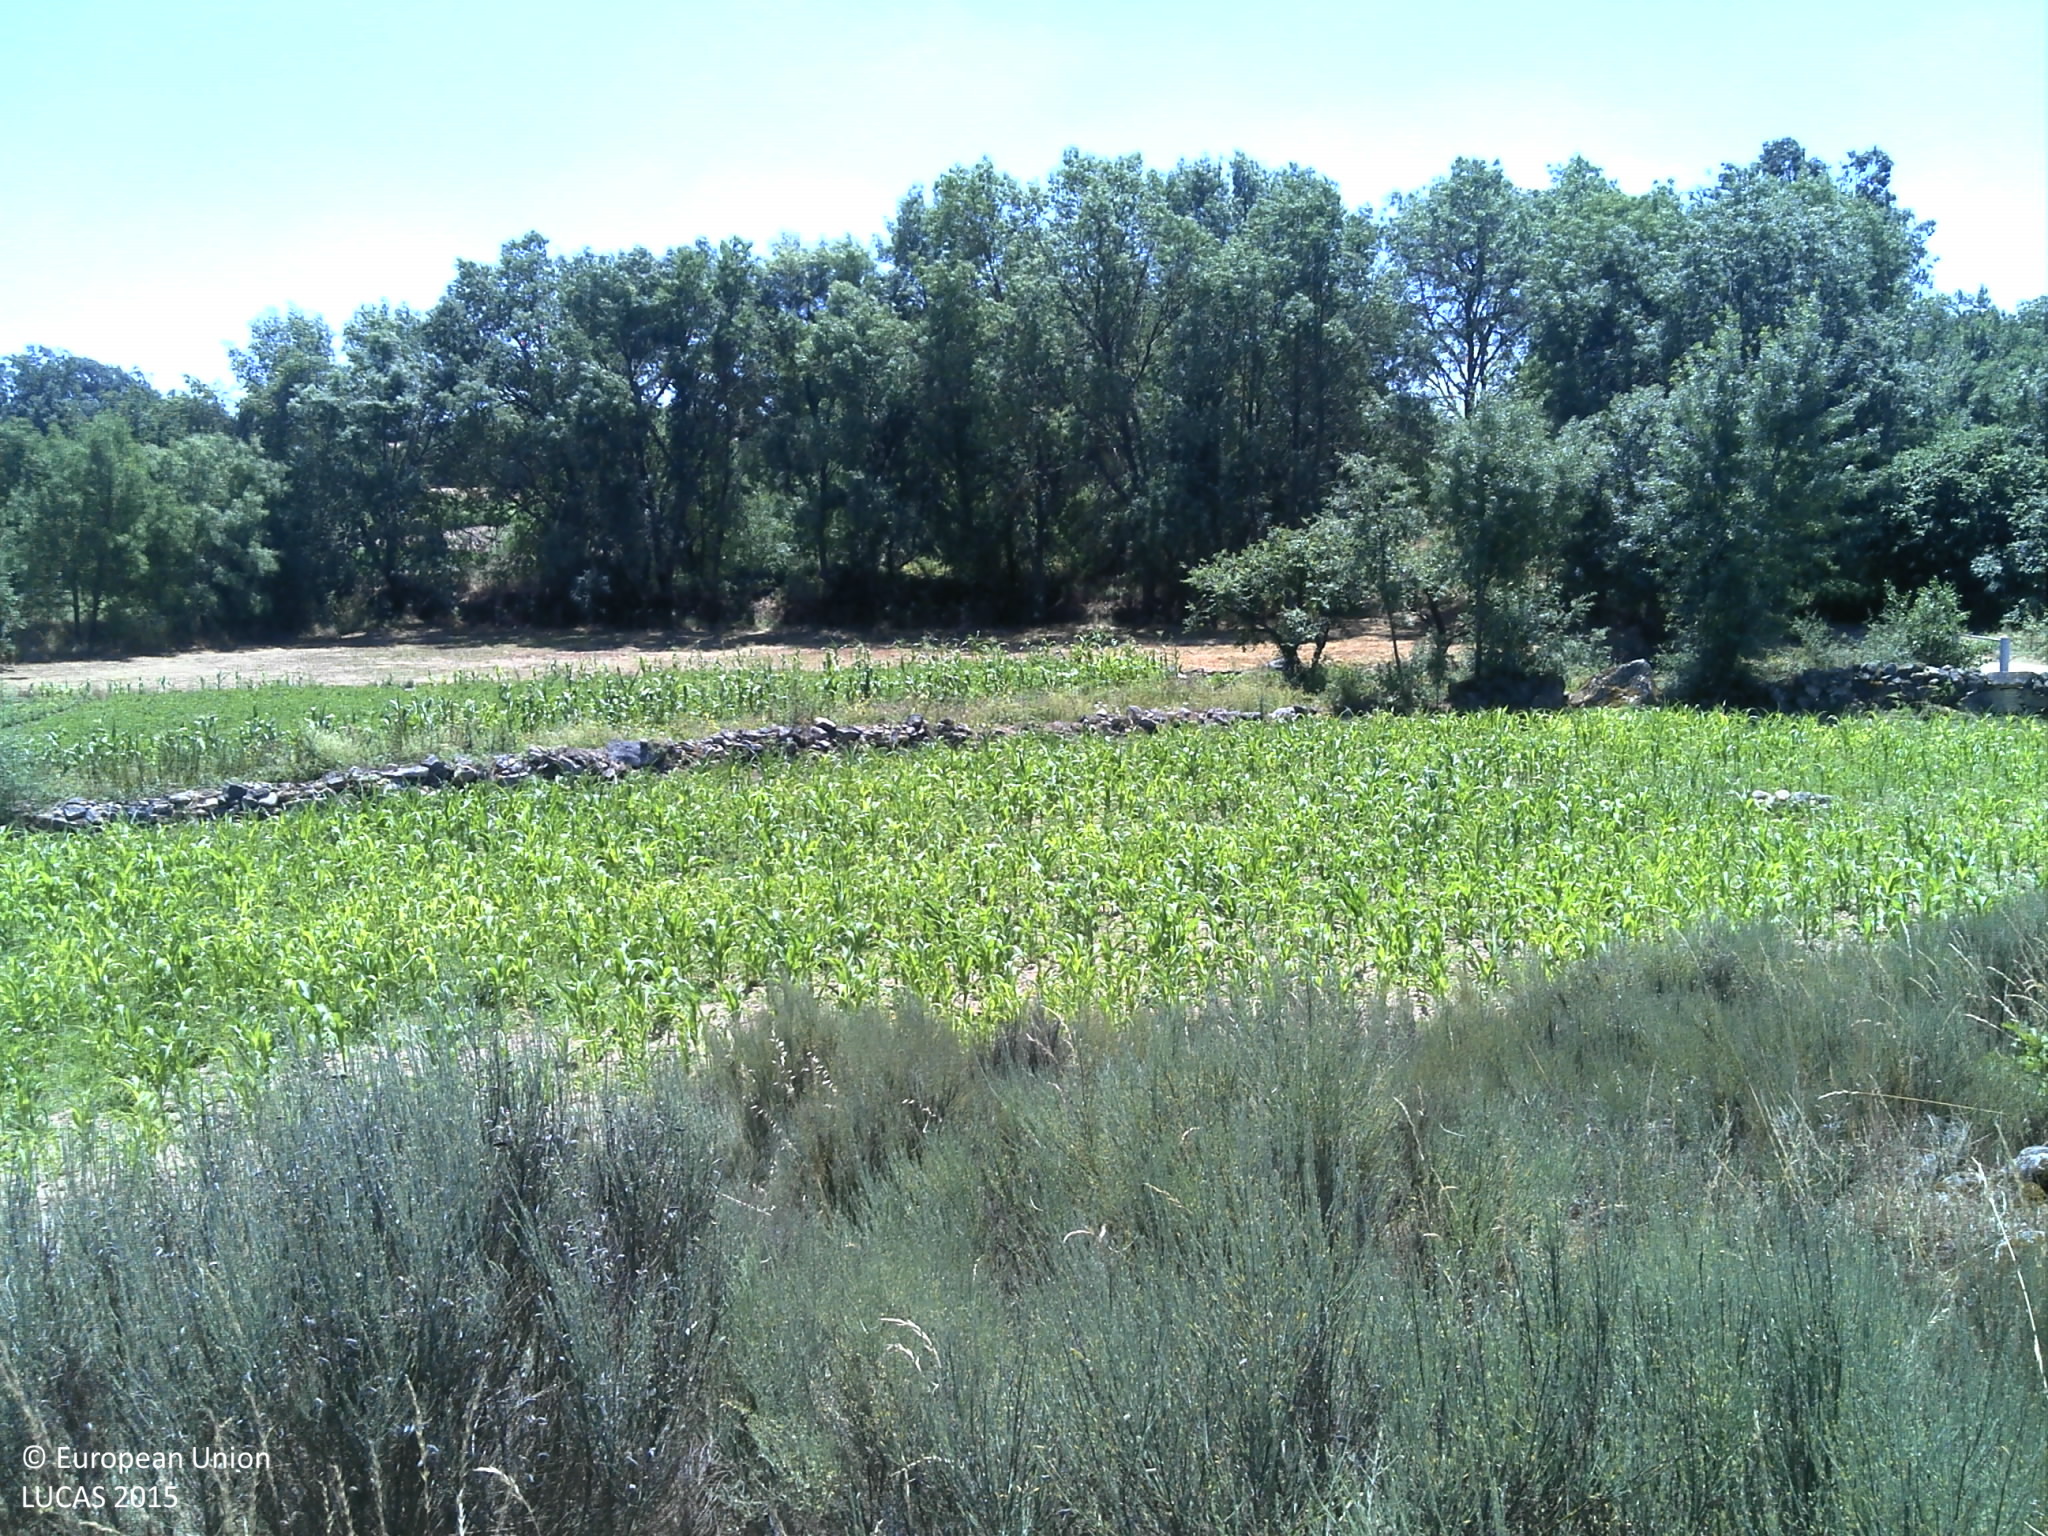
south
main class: Shrubland
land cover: Shrubland without tree cover
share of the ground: 50 - 75 %
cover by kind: shrubs 50 %, consolidated bare surface 30 %, herbaceous plants 10 %, unconsolidated bare surface 10 %
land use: Abandoned areas
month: June
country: PT
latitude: 40.7719
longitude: -7.1559
